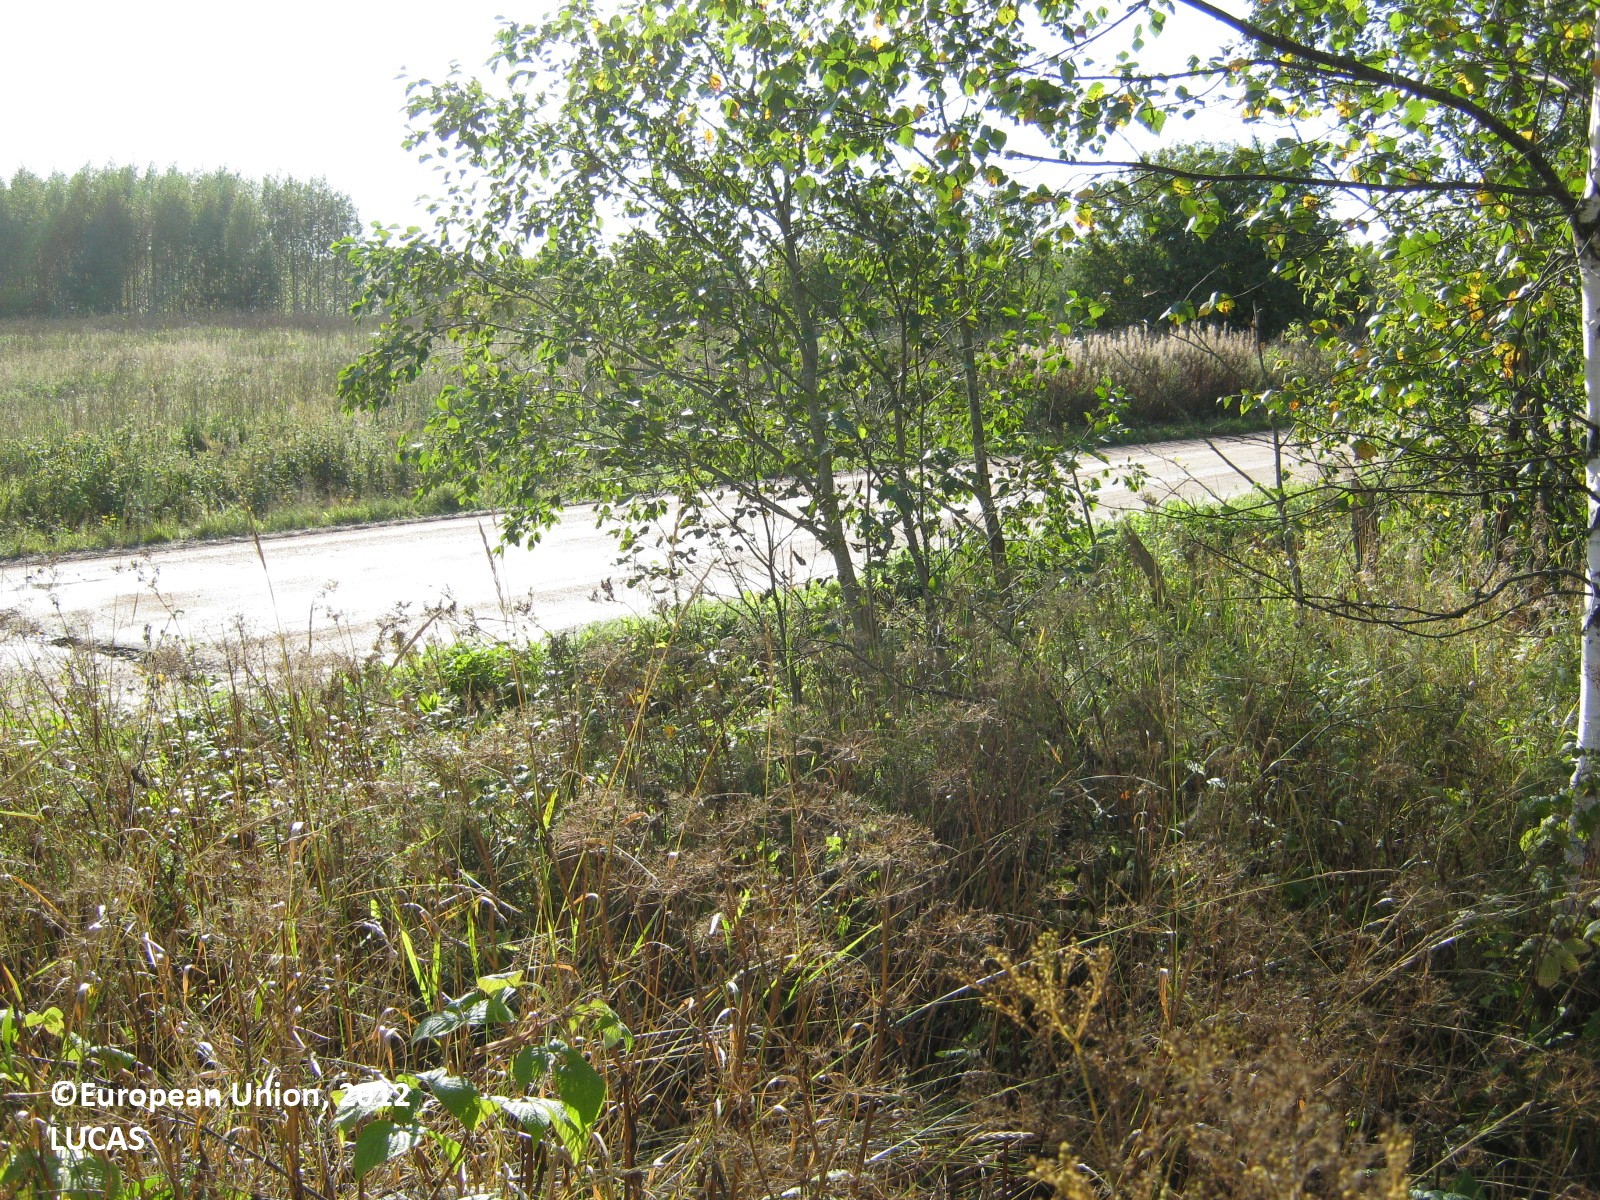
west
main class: Woodland
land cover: Broadleaved woodland
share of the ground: > 75 %
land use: Forestry
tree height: > 5 m
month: September
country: FI
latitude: 60.6665
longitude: 27.9317
